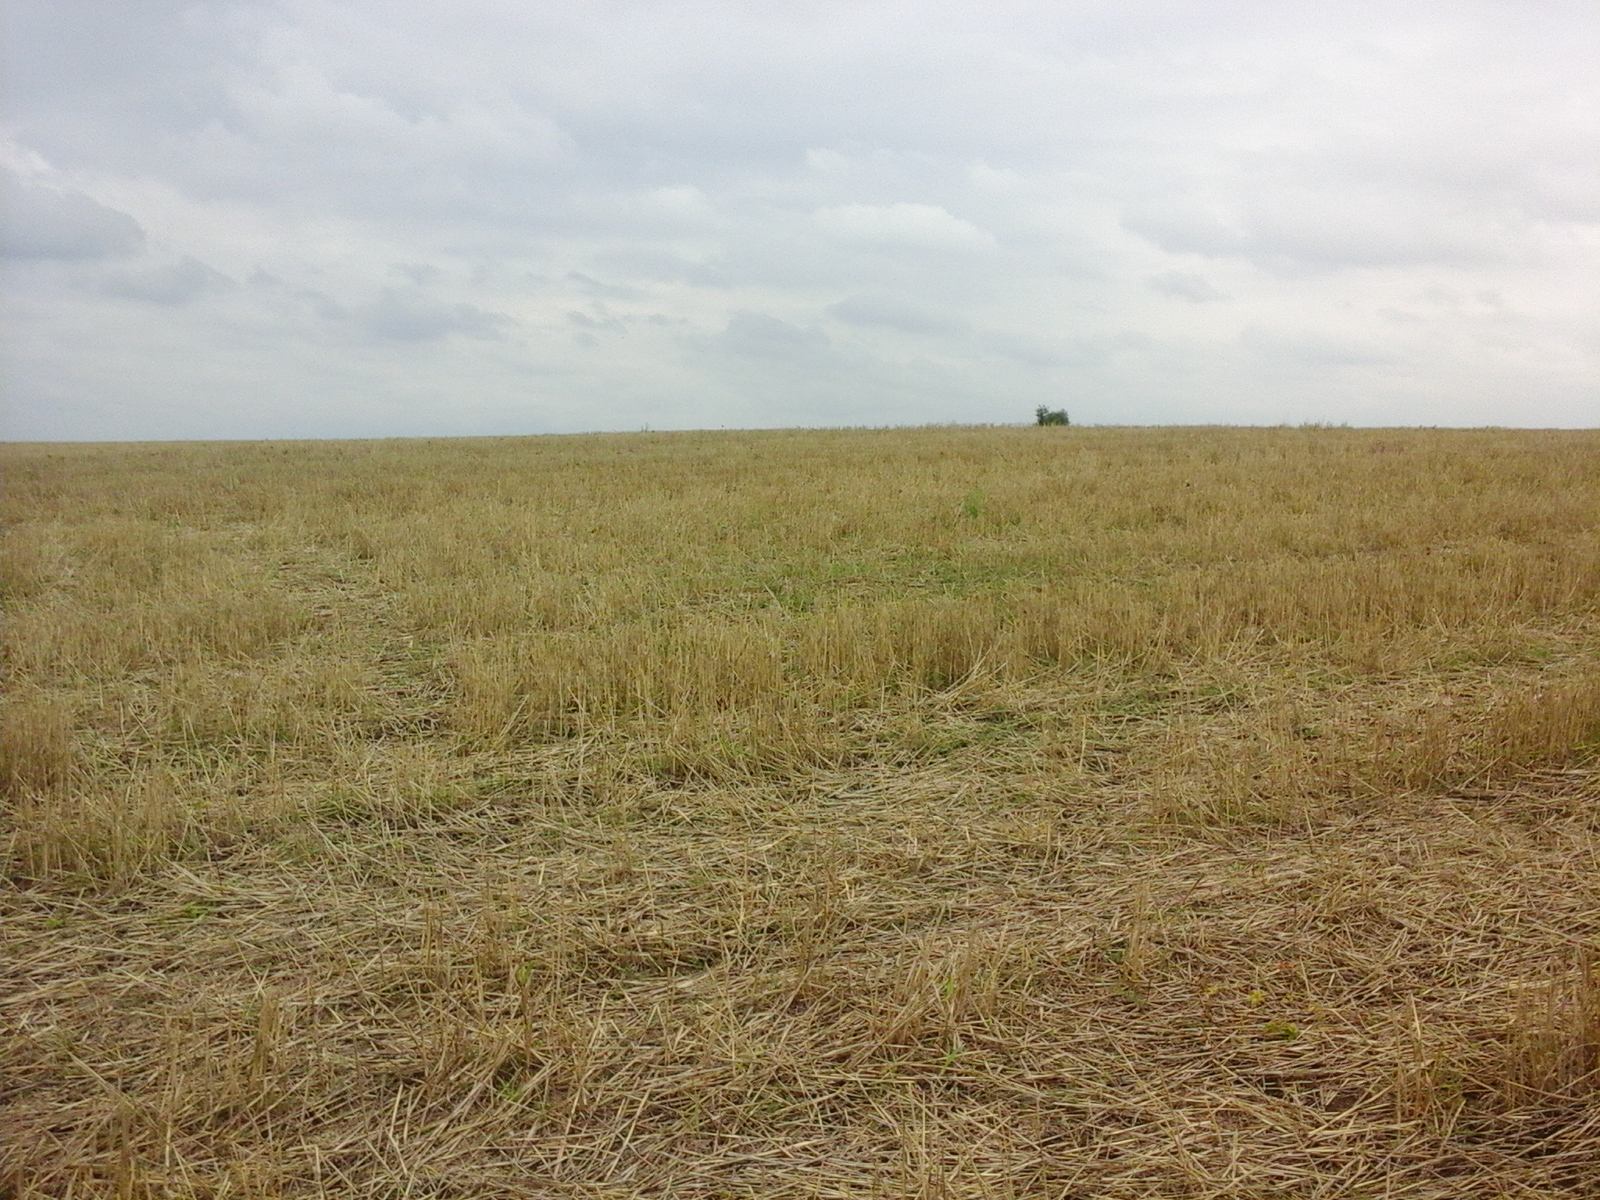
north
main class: Cropland
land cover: Common wheat
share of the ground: 50 - 75 %
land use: Agriculture (excluding fallow land and kitchen gardens)
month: August
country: RO
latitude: 45.5487
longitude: 21.3149
